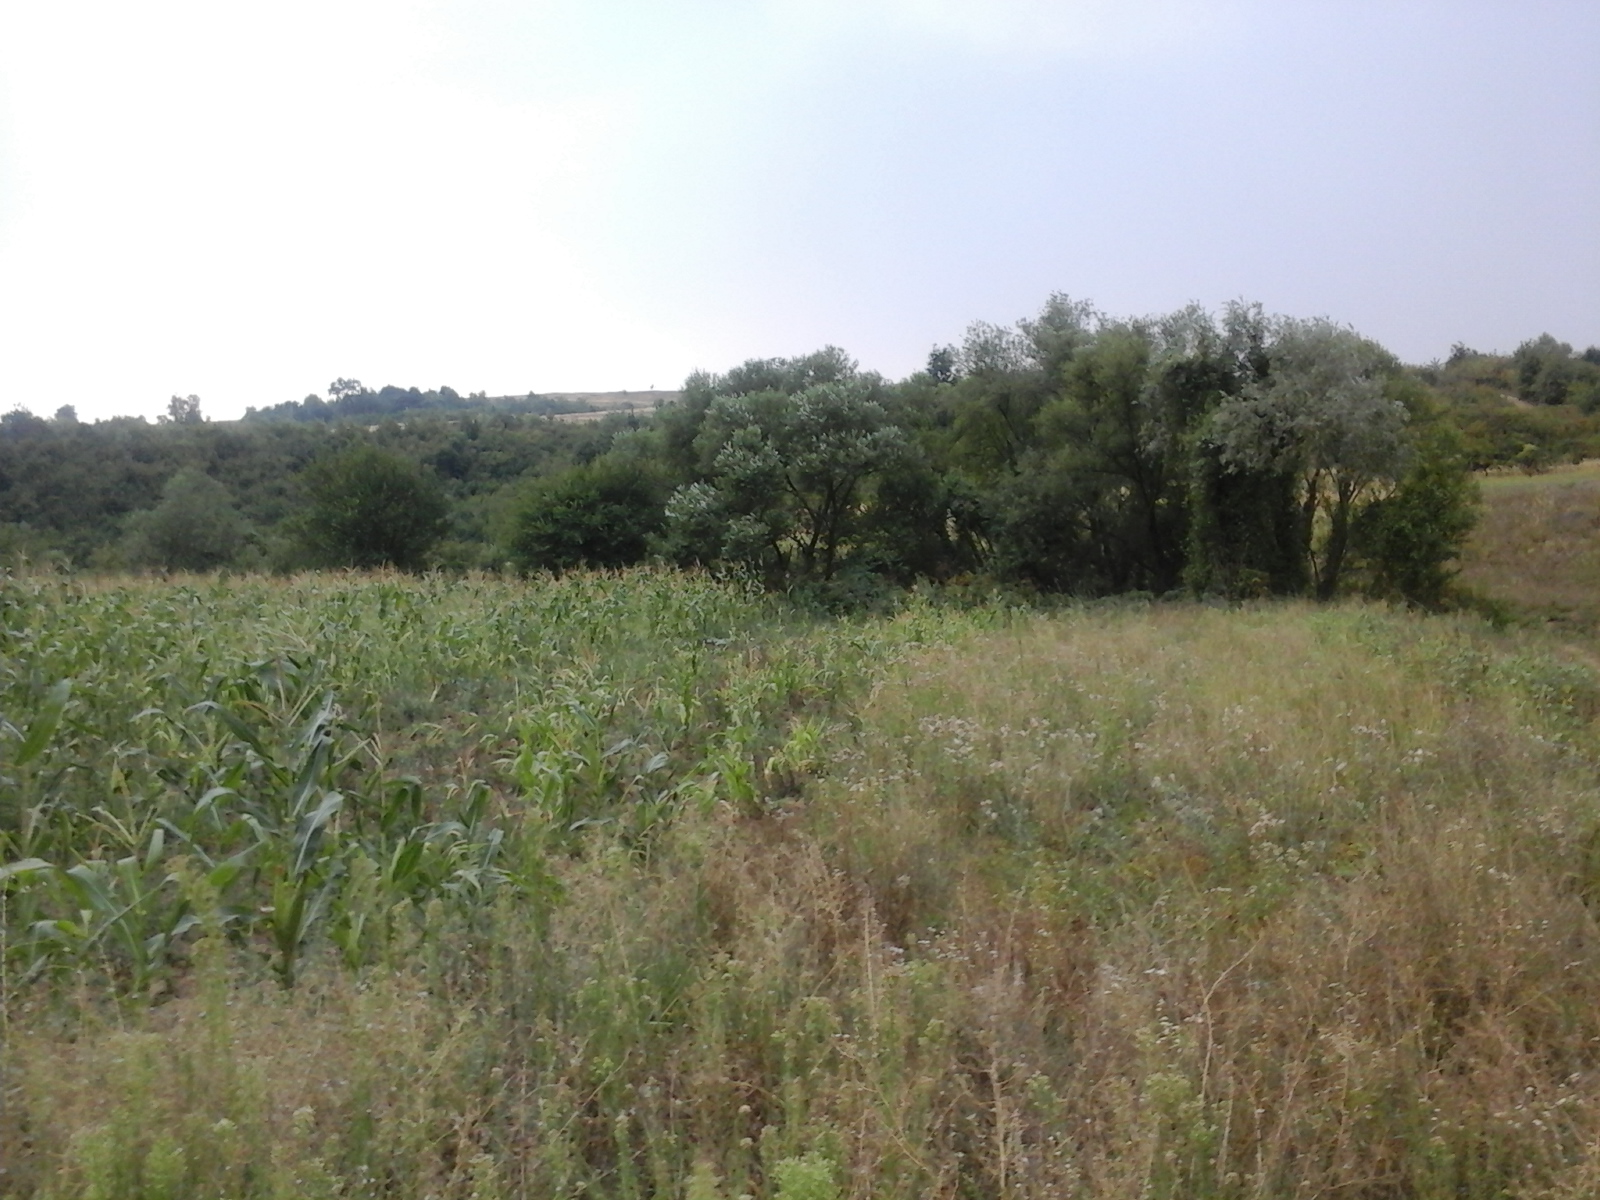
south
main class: Grassland
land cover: Spontaneously vegetated surfaces
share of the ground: > 75 %
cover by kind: herbaceous plants 100 %
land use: Agriculture (excluding fallow land and kitchen gardens)
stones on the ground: < 10 %
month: August
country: RO
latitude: 44.6369
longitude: 23.3263
